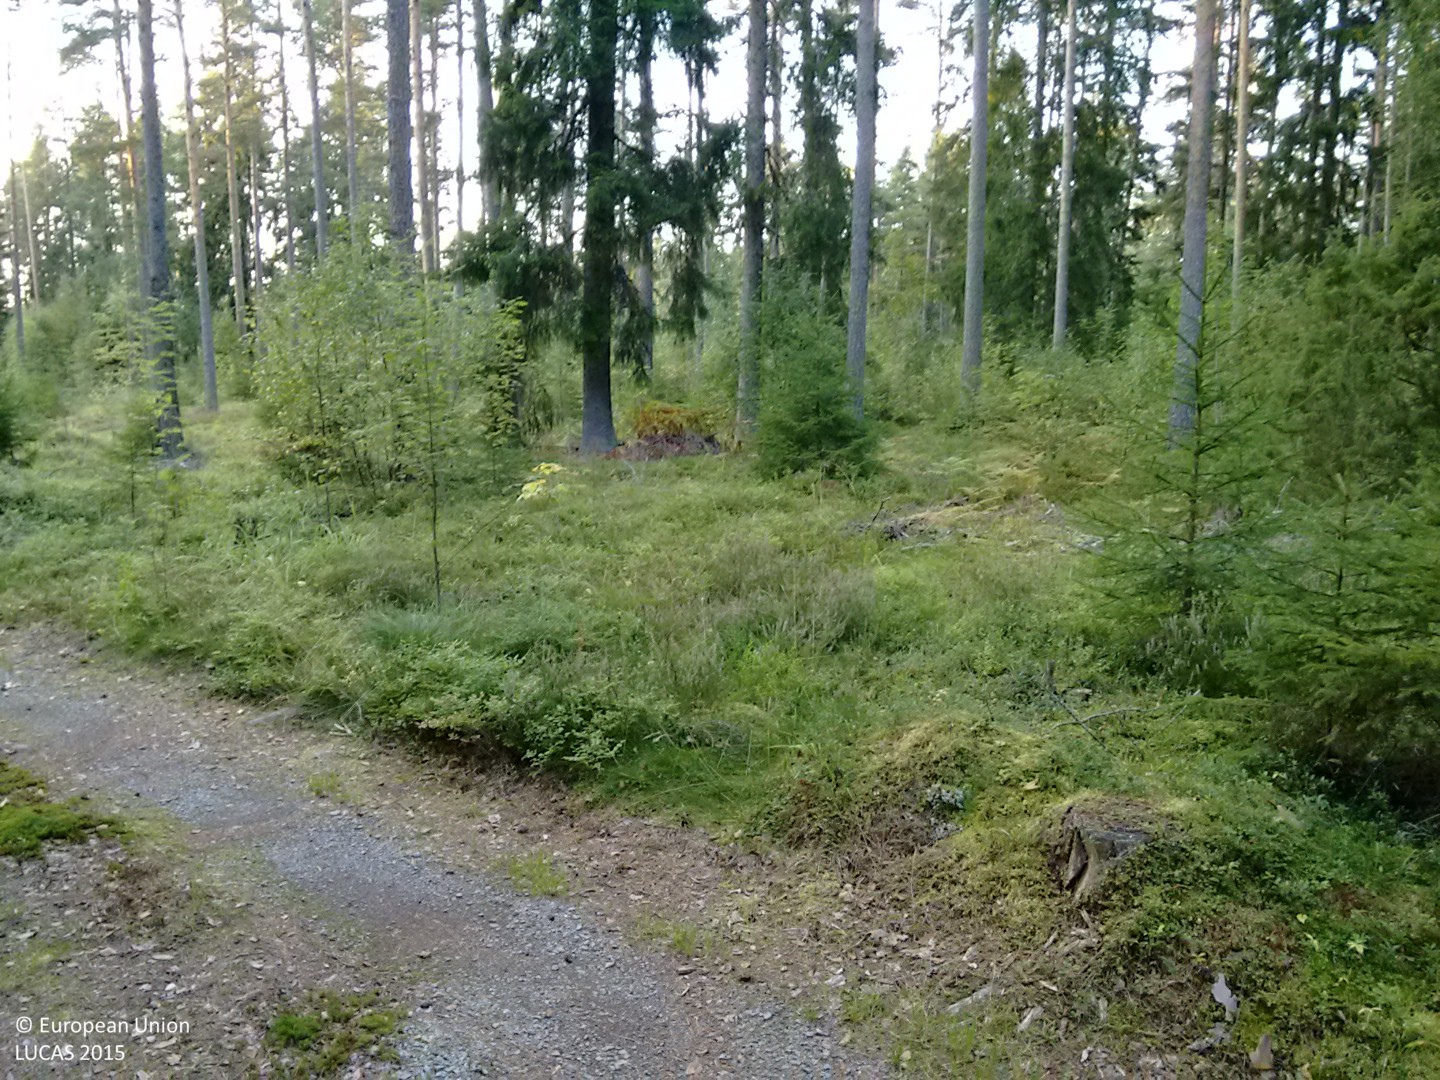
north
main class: Woodland
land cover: Spruce dominated coniferous woodland
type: hemiboreal forest and nemoral coniferous forest and mixed broadleaved-coniferous forest
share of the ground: > 75 %
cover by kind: coniferous forest trees 70 %, shrubs 15 %, herbaceous plants 10 %, broadleaved forest trees 5 %
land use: Forestry
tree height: > 5 m
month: September
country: FI
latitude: 60.9051
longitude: 21.8017
